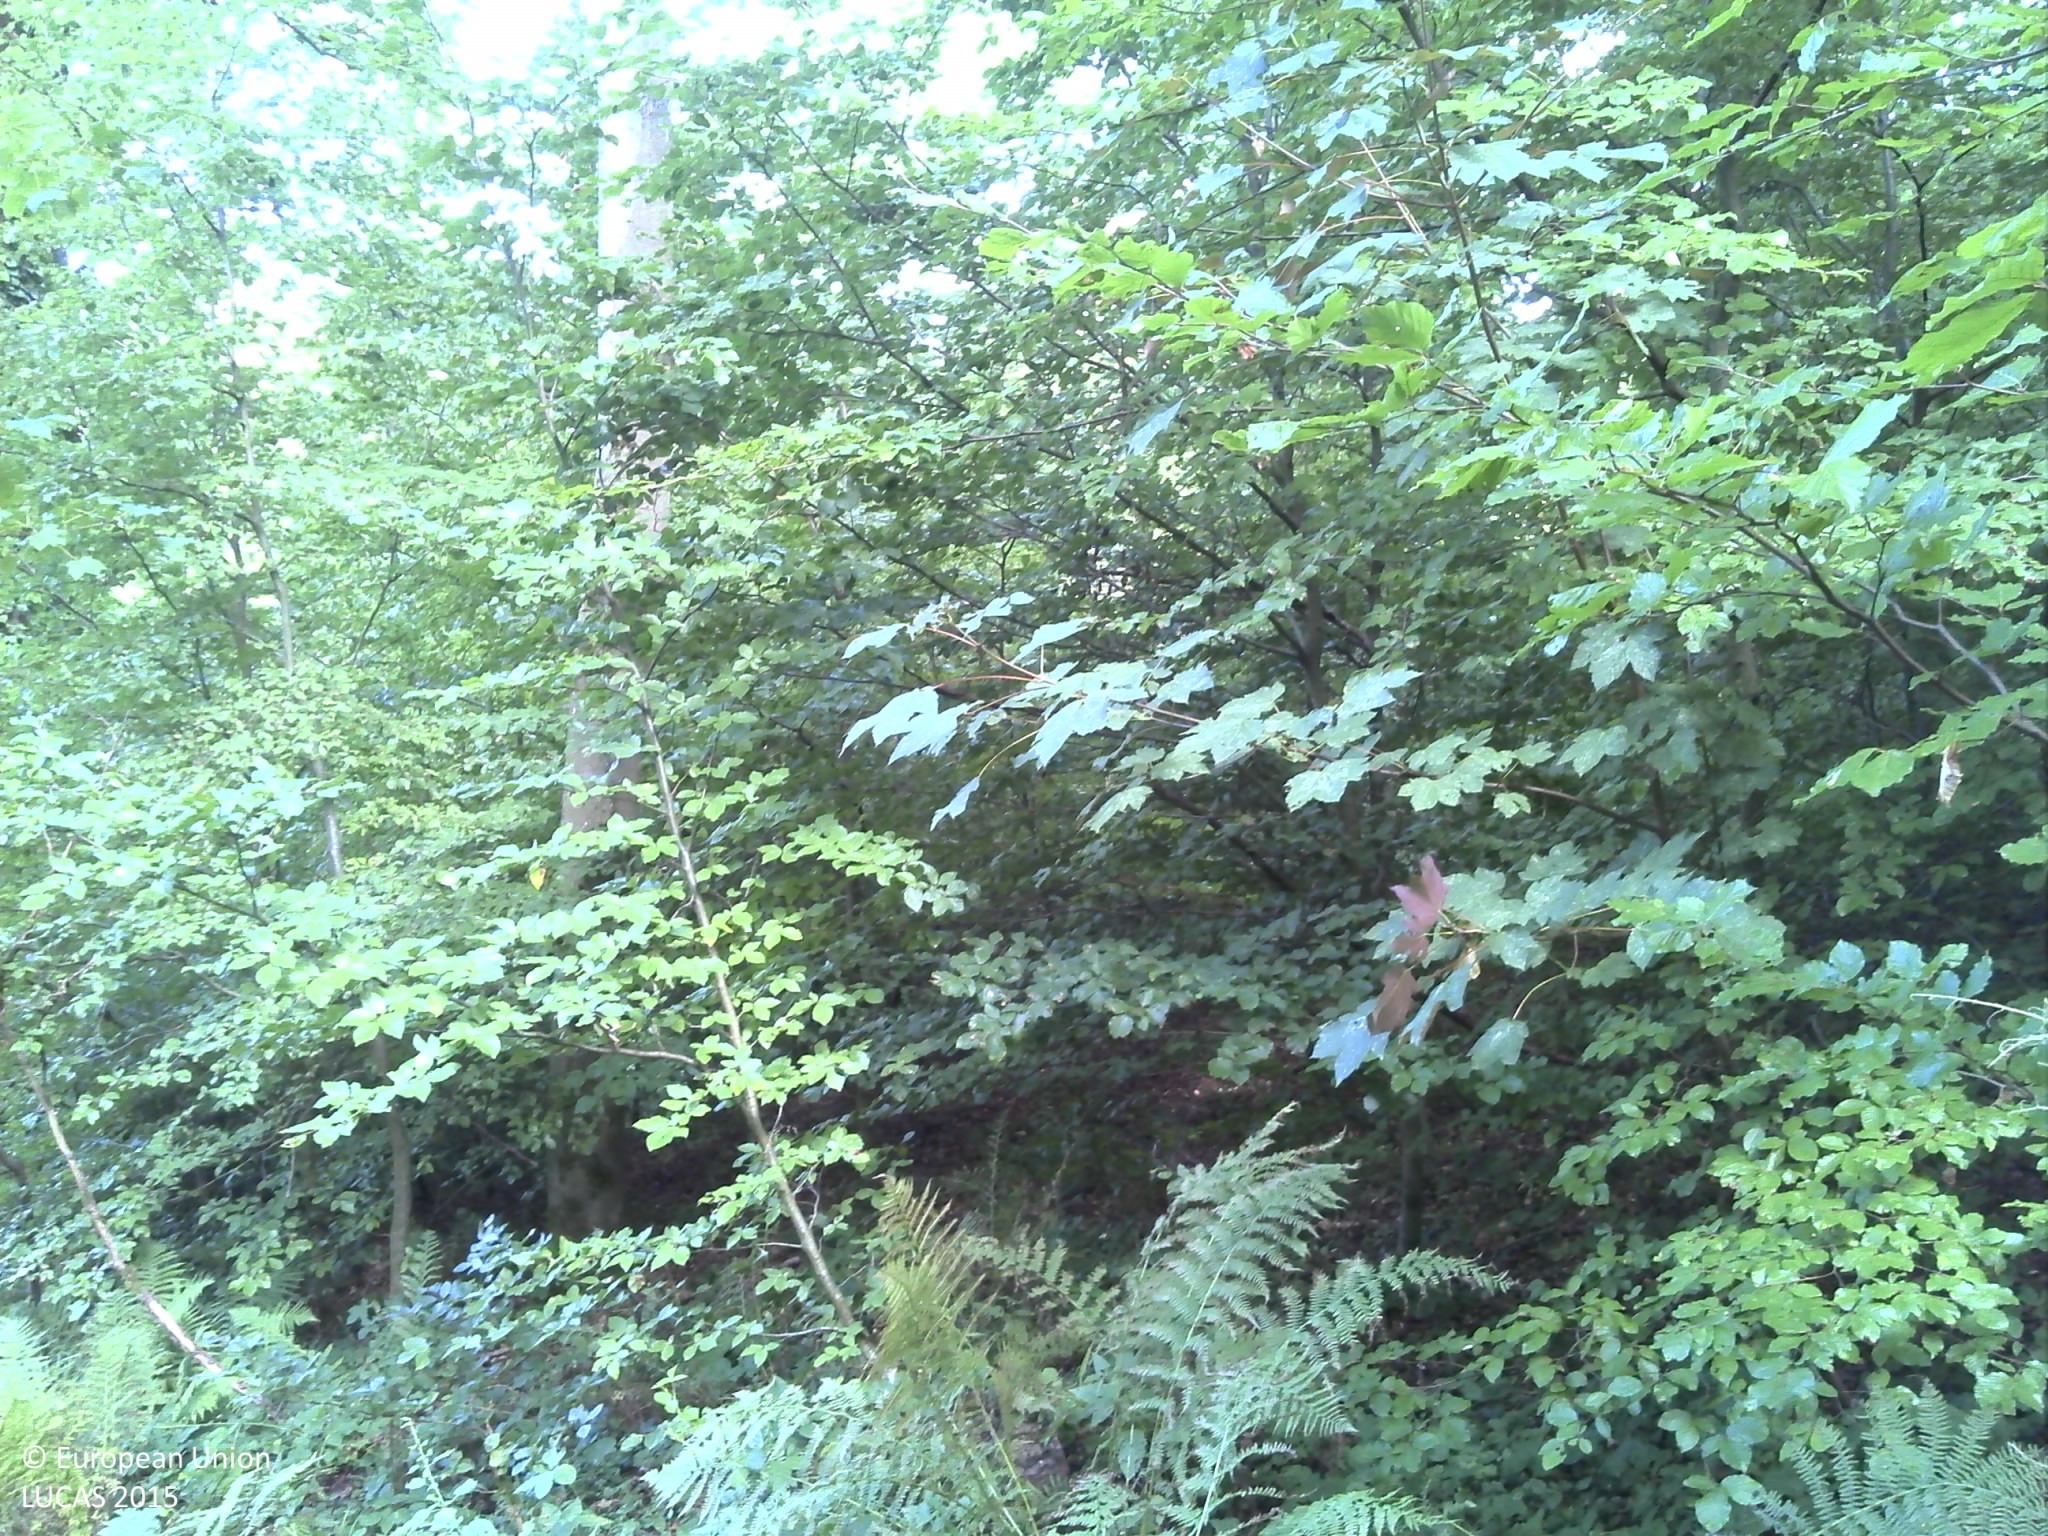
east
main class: Woodland
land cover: Broadleaved woodland
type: beech forest
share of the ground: > 75 %
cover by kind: broadleaved forest trees 85 %, herbaceous plants 10 %, consolidated bare surface 5 %
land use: Forestry
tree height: > 5 m
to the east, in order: Broadleaved woodland; Grass margins; Paved roads, cycling and walking lanes
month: August
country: LU
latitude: 49.6497
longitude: 6.1074
